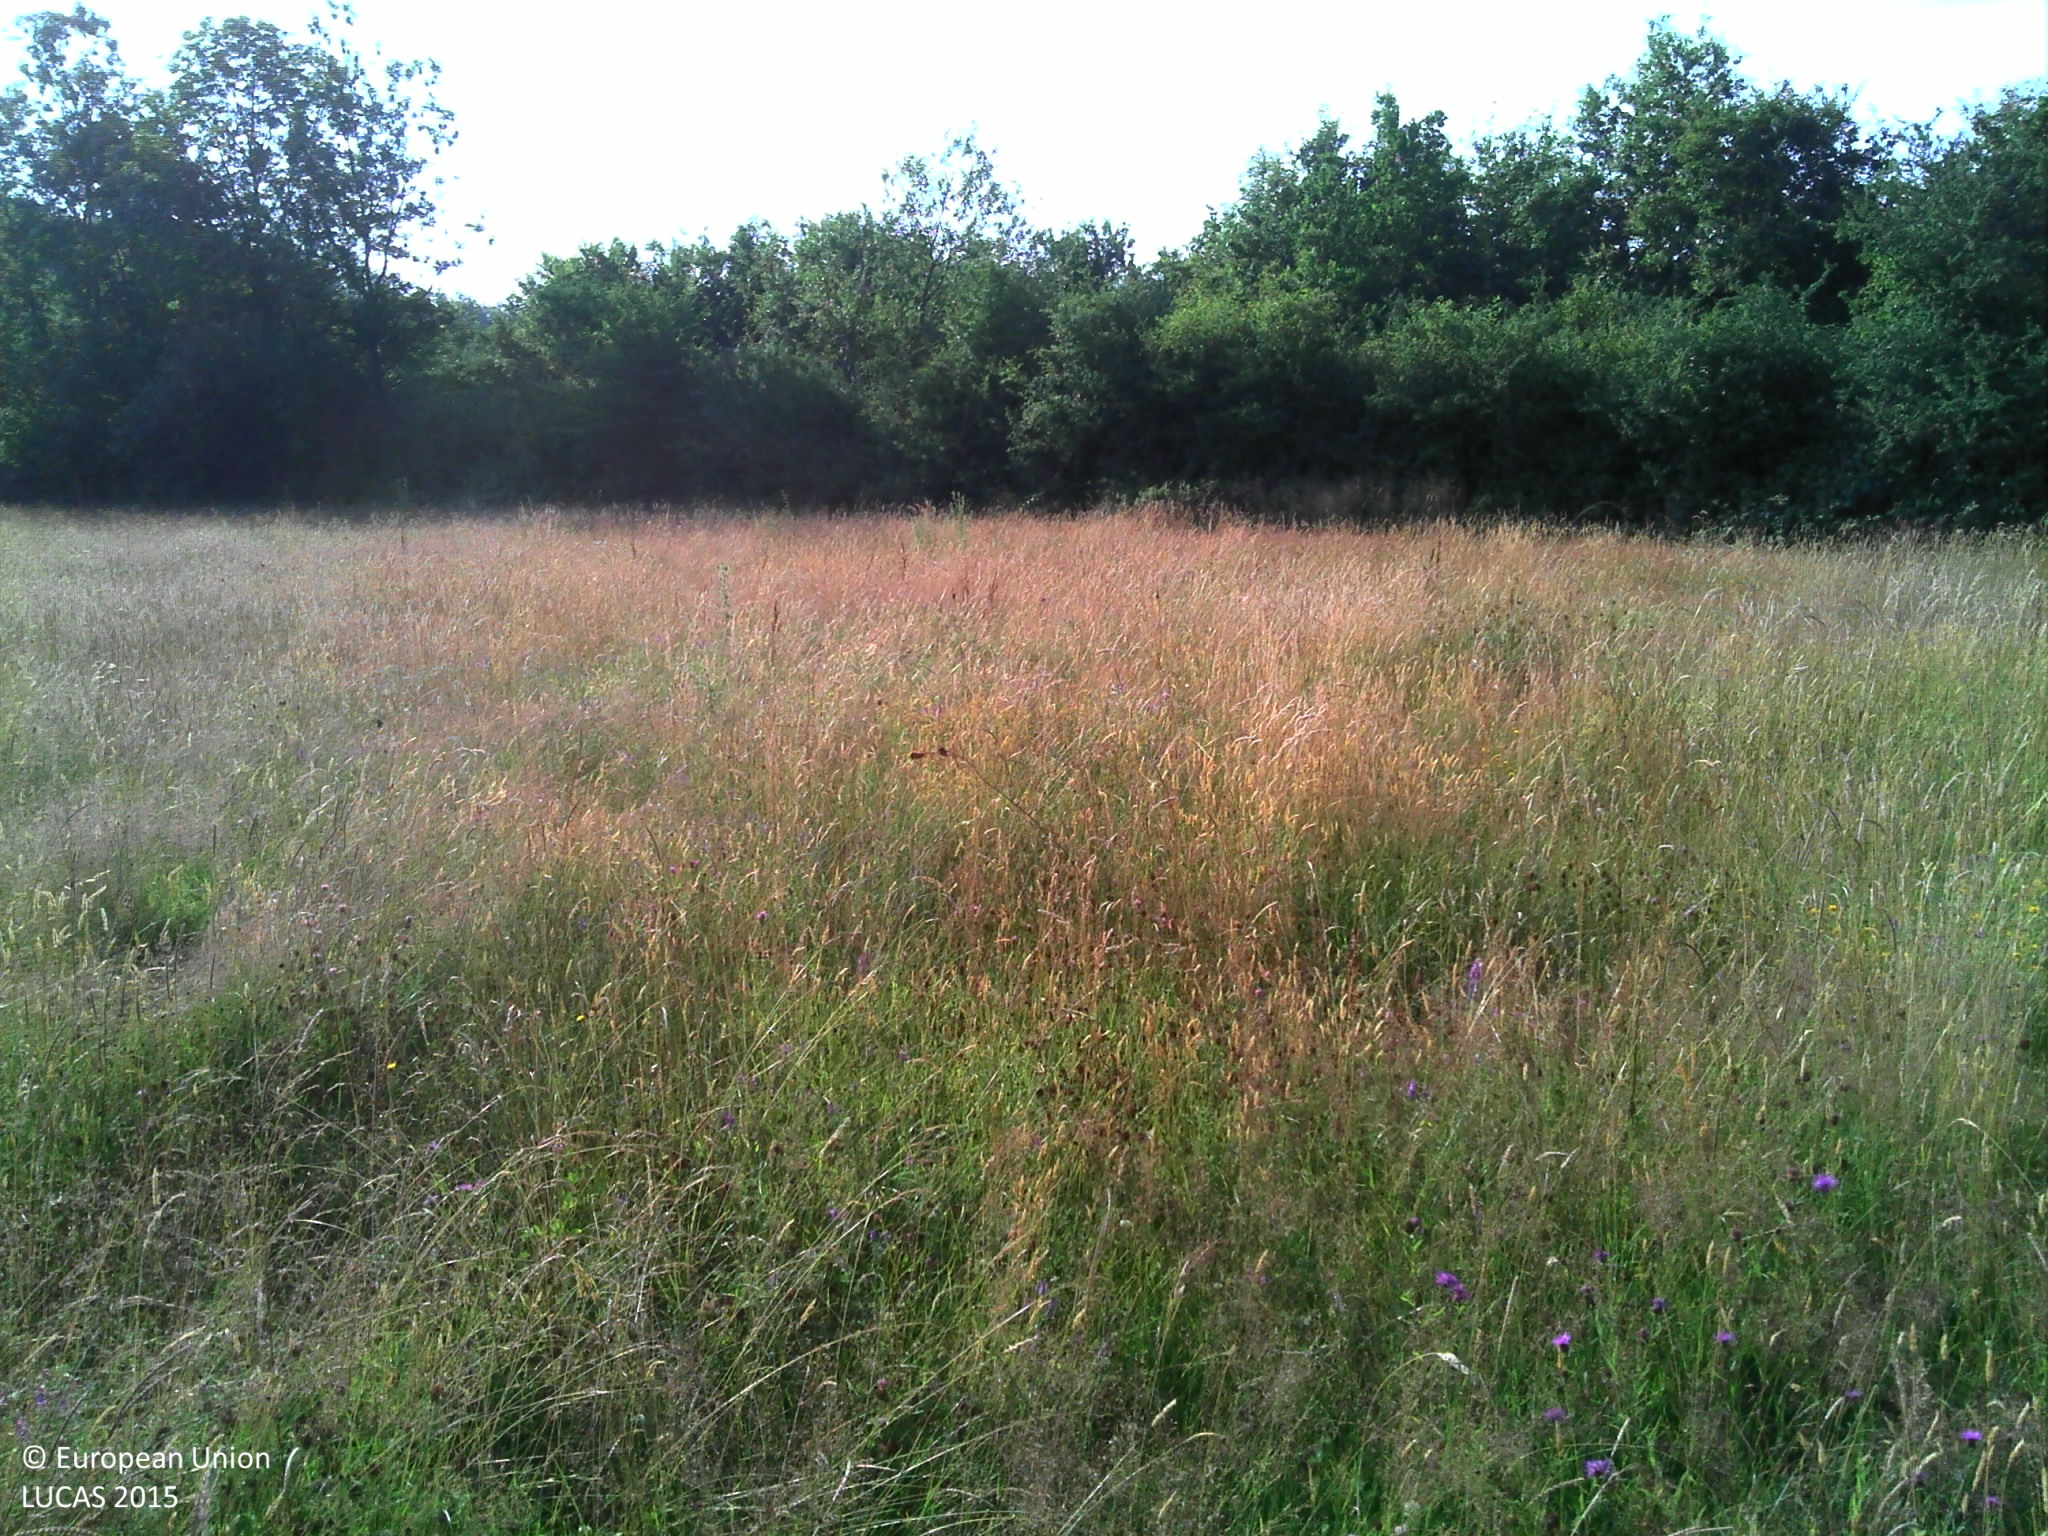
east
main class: Grassland
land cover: Grassland without tree/shrub cover
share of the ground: > 75 %
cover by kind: herbaceous plants 100 %
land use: Agriculture (excluding fallow land and kitchen gardens)
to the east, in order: Grassland without tree/shrub cover; Fences; Broadleaved woodland
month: July
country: FR
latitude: 47.1873
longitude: 3.5702
